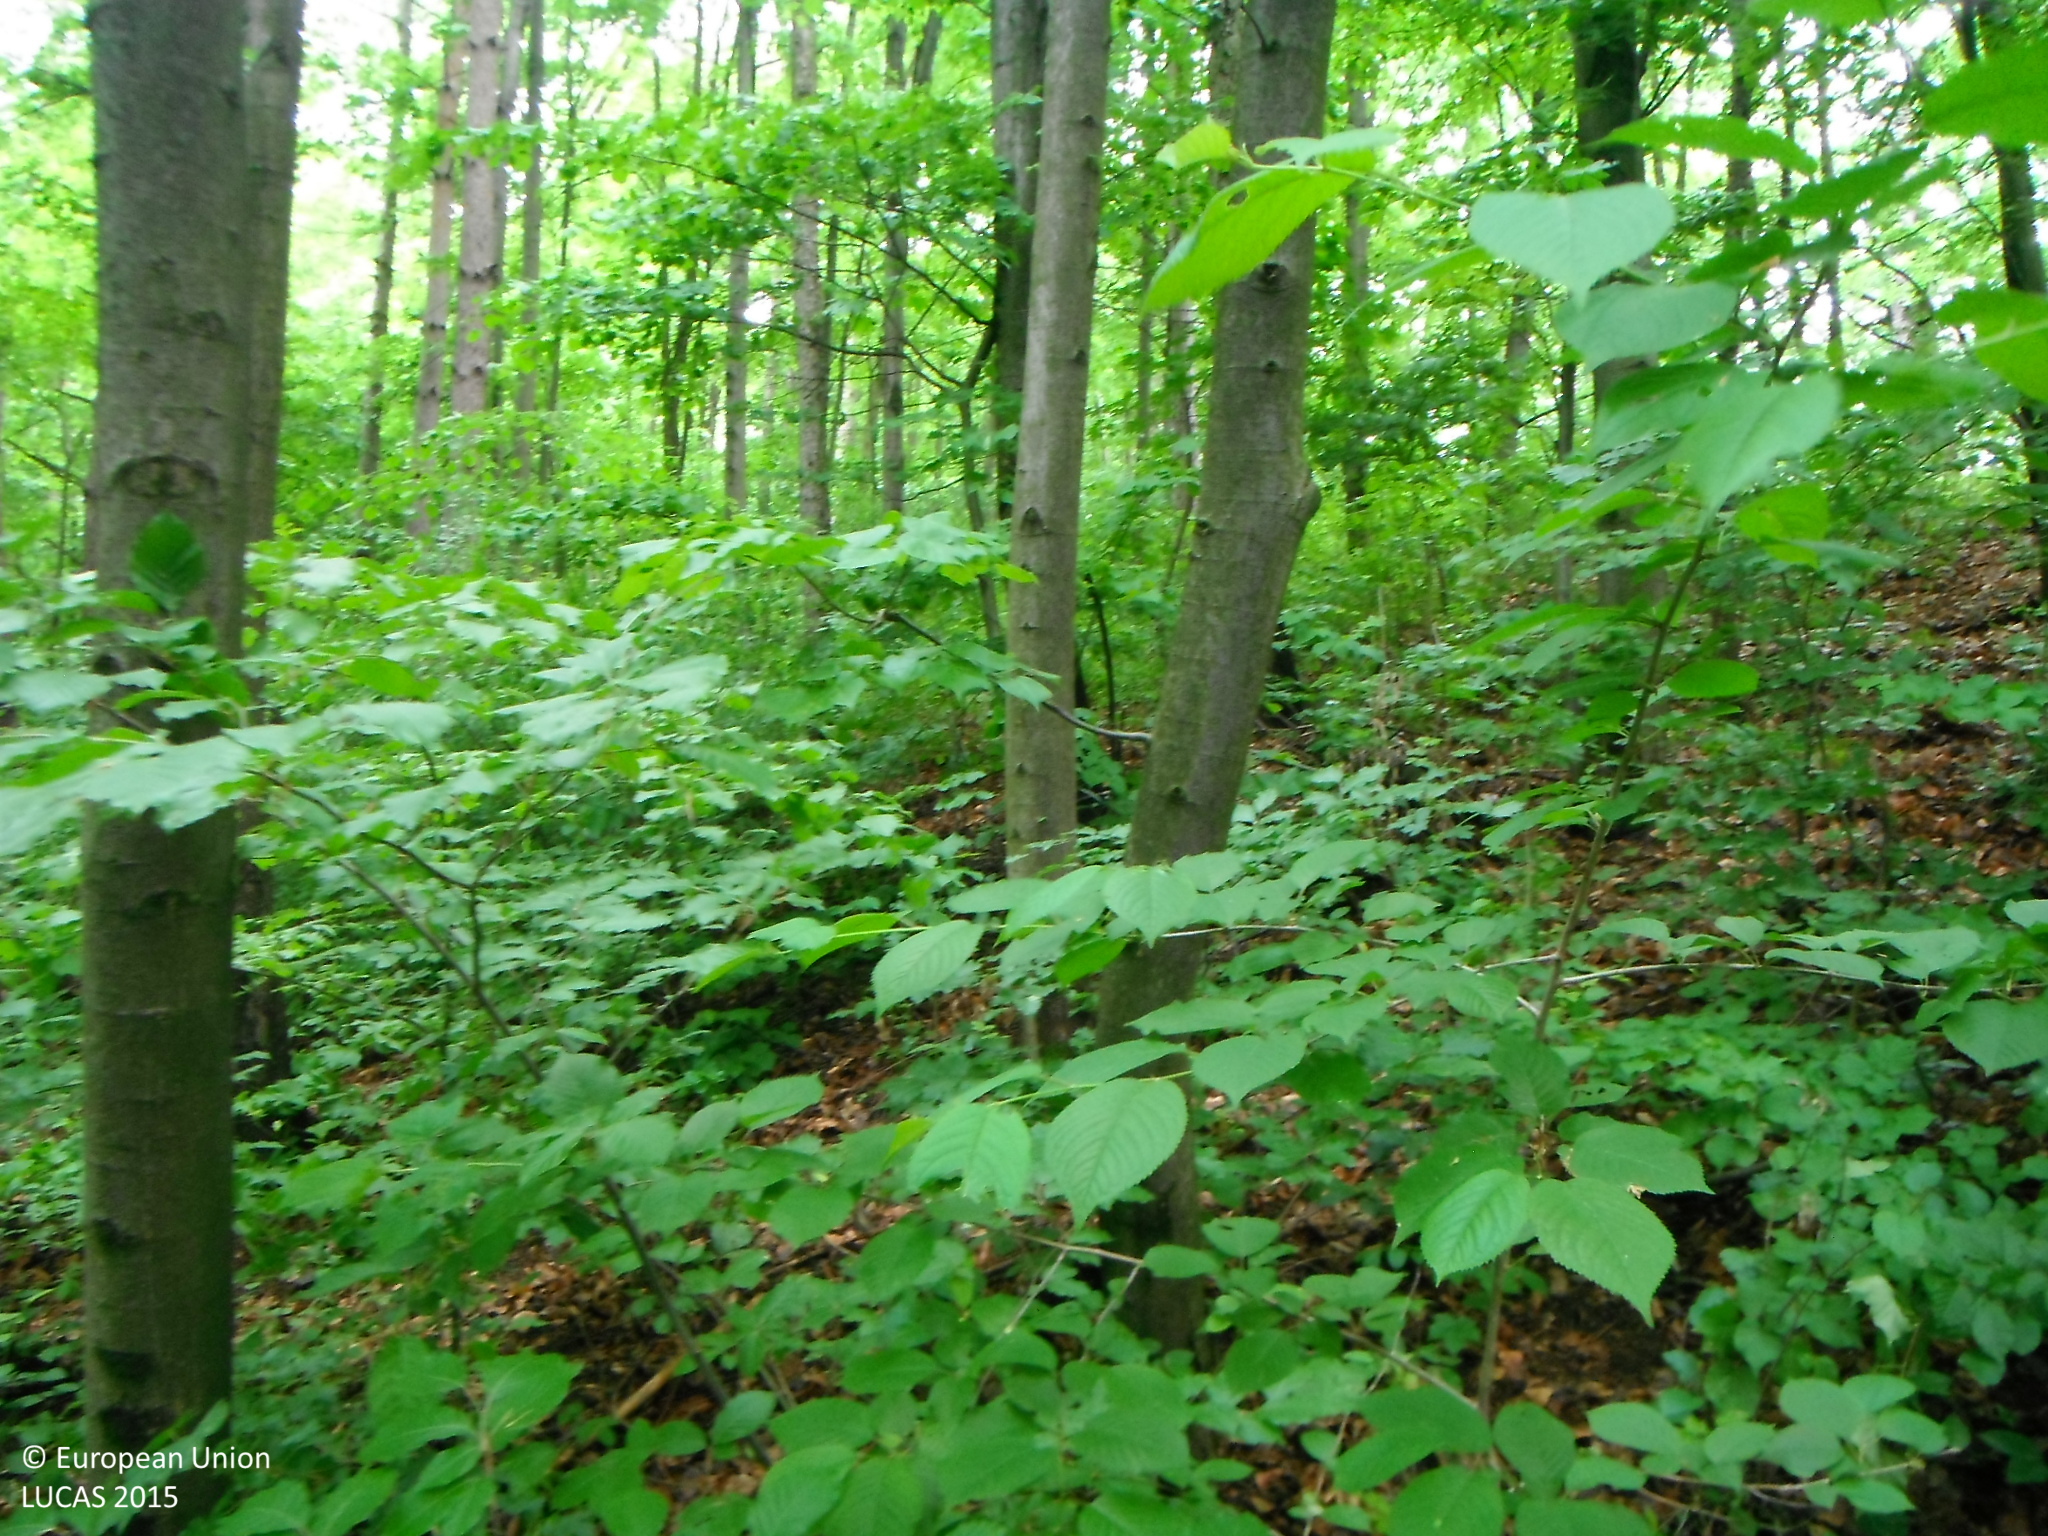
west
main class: Woodland
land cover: Other mixed woodland
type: hemiboreal forest and nemoral coniferous forest and mixed broadleaved-coniferous forest
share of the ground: > 75 %
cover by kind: broadleaved forest trees 60 %, coniferous forest trees 40 %
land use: Forestry
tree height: > 5 m
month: May
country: SK
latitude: 48.7300
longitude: 19.1448
